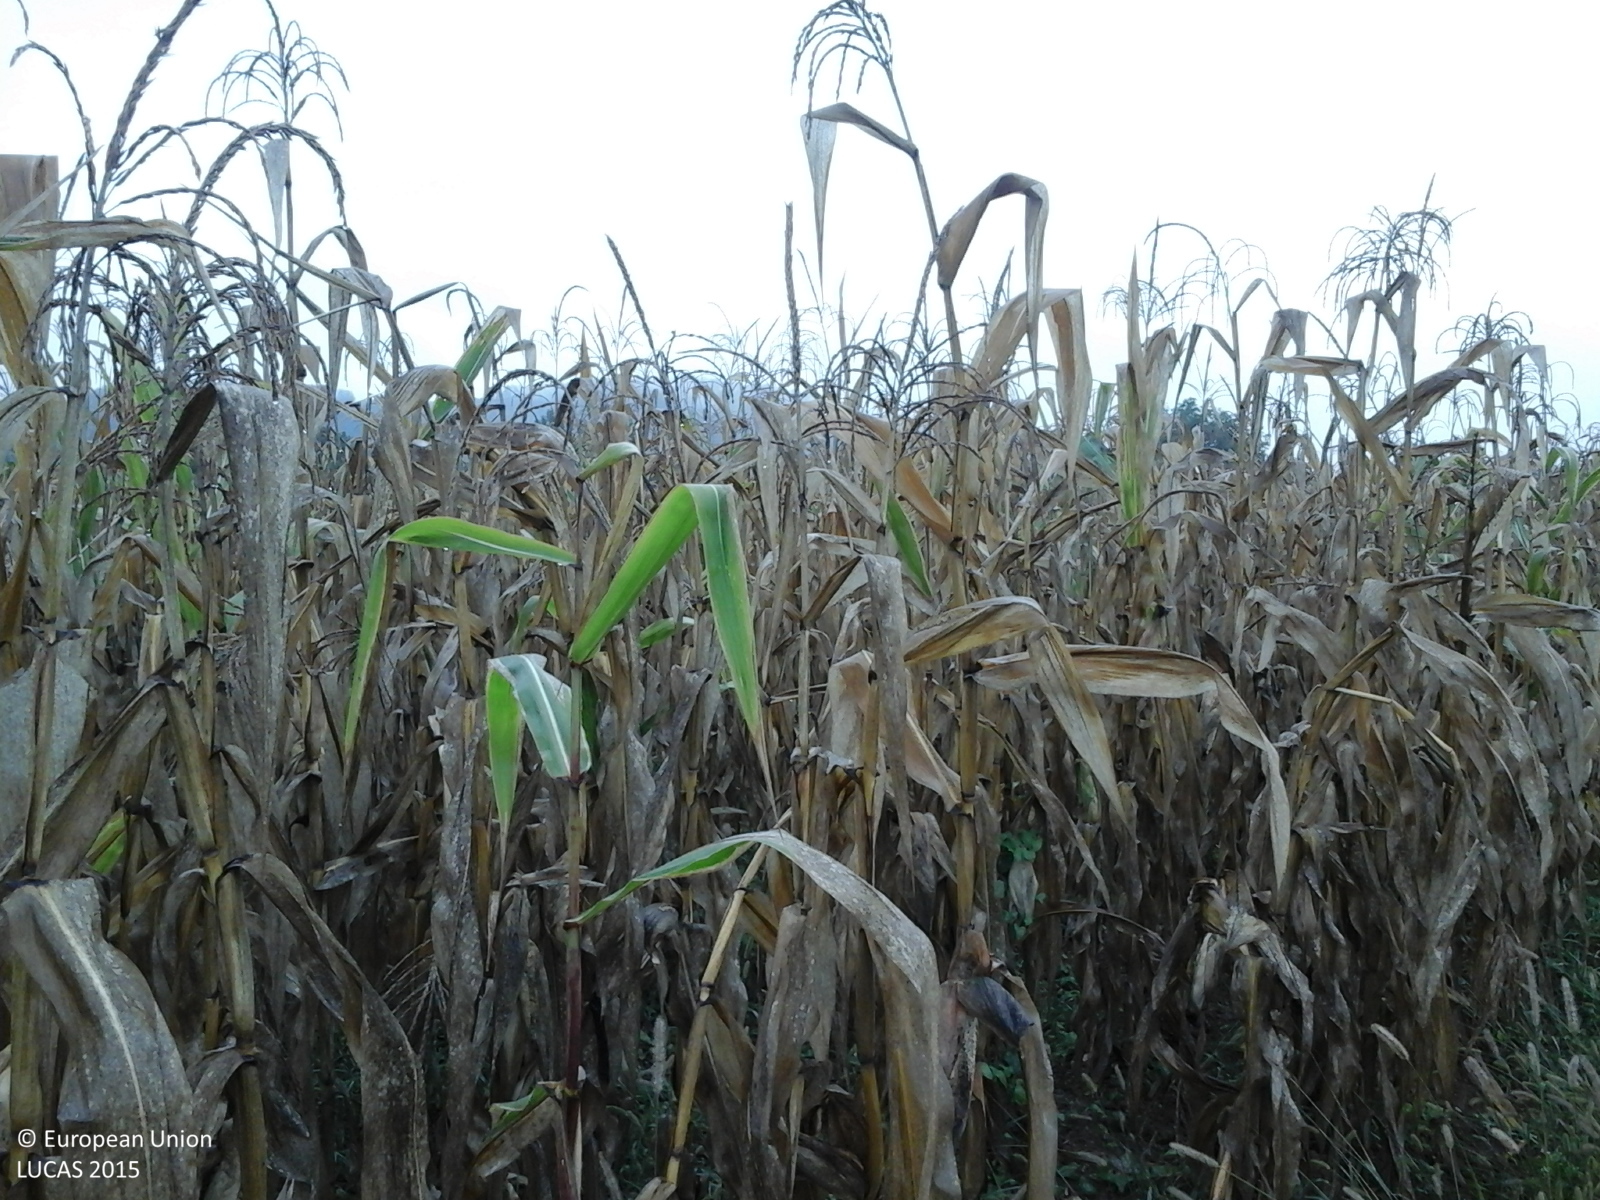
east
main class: Cropland
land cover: Maize
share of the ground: > 75 %
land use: Agriculture (excluding fallow land and kitchen gardens)
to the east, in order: Grass margins; Maize; Spontaneously vegetated surfaces; Grassland without tree/shrub cover; Tracks; Grass margins; Lucerne; Maize; Broadleaved woodland; Fences; Broadleaved woodland; Spontaneously vegetated surfaces; Rivers and streams; Spontaneously vegetated surfaces; Grassland without tree/shrub cover; Rocks and stones; Paved roads, cycling and walking lanes
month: September
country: RO
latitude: 47.0364
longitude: 22.4906
